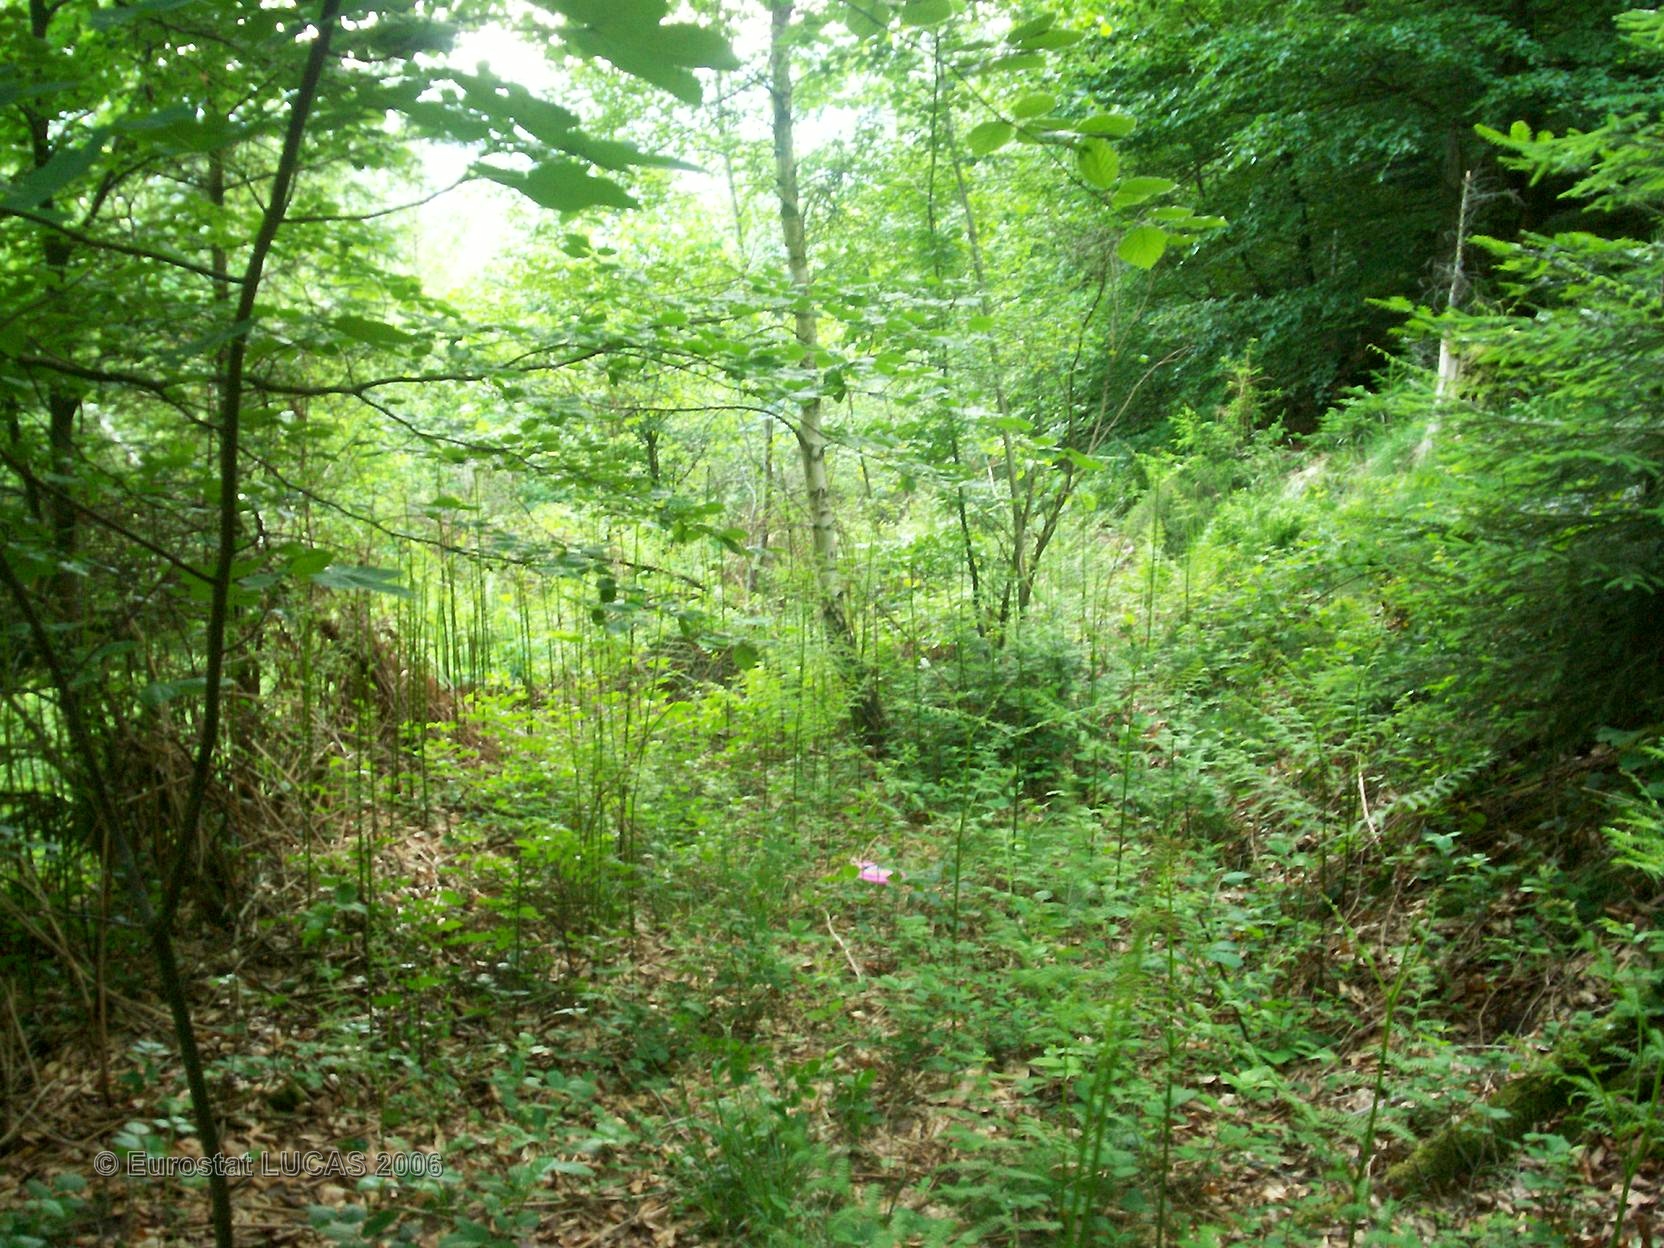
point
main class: Woodland
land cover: Mixed forest
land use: Forestry
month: June
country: FR
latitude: 48.4891
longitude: 7.0104
